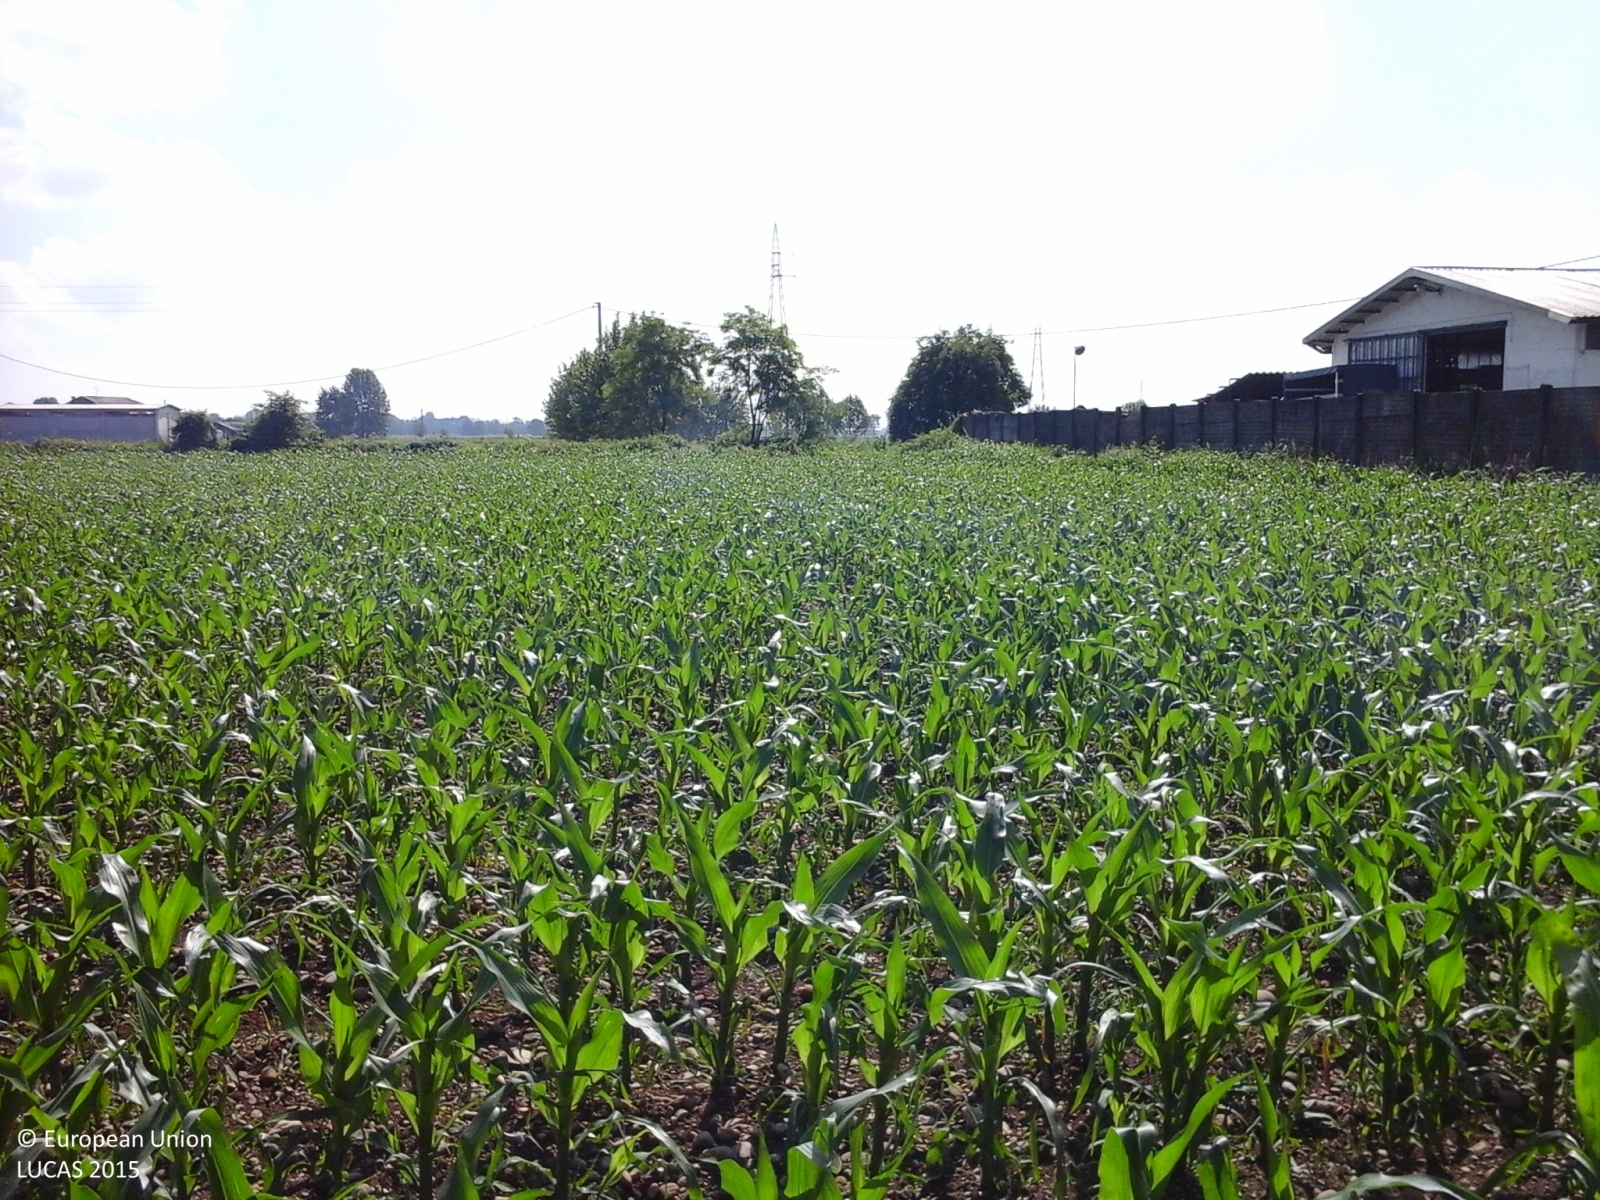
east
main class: Cropland
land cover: Maize
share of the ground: 50 - 75 %
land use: Agriculture (excluding fallow land and kitchen gardens)
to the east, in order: Maize; Managed hedges; Inland fresh running water; Managed hedges; Maize; Electric lines; Maize; Managed hedges; Grass margins; Ditches and canals; Grass margins; Maize
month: May
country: IT
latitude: 45.4133
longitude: 9.5536
